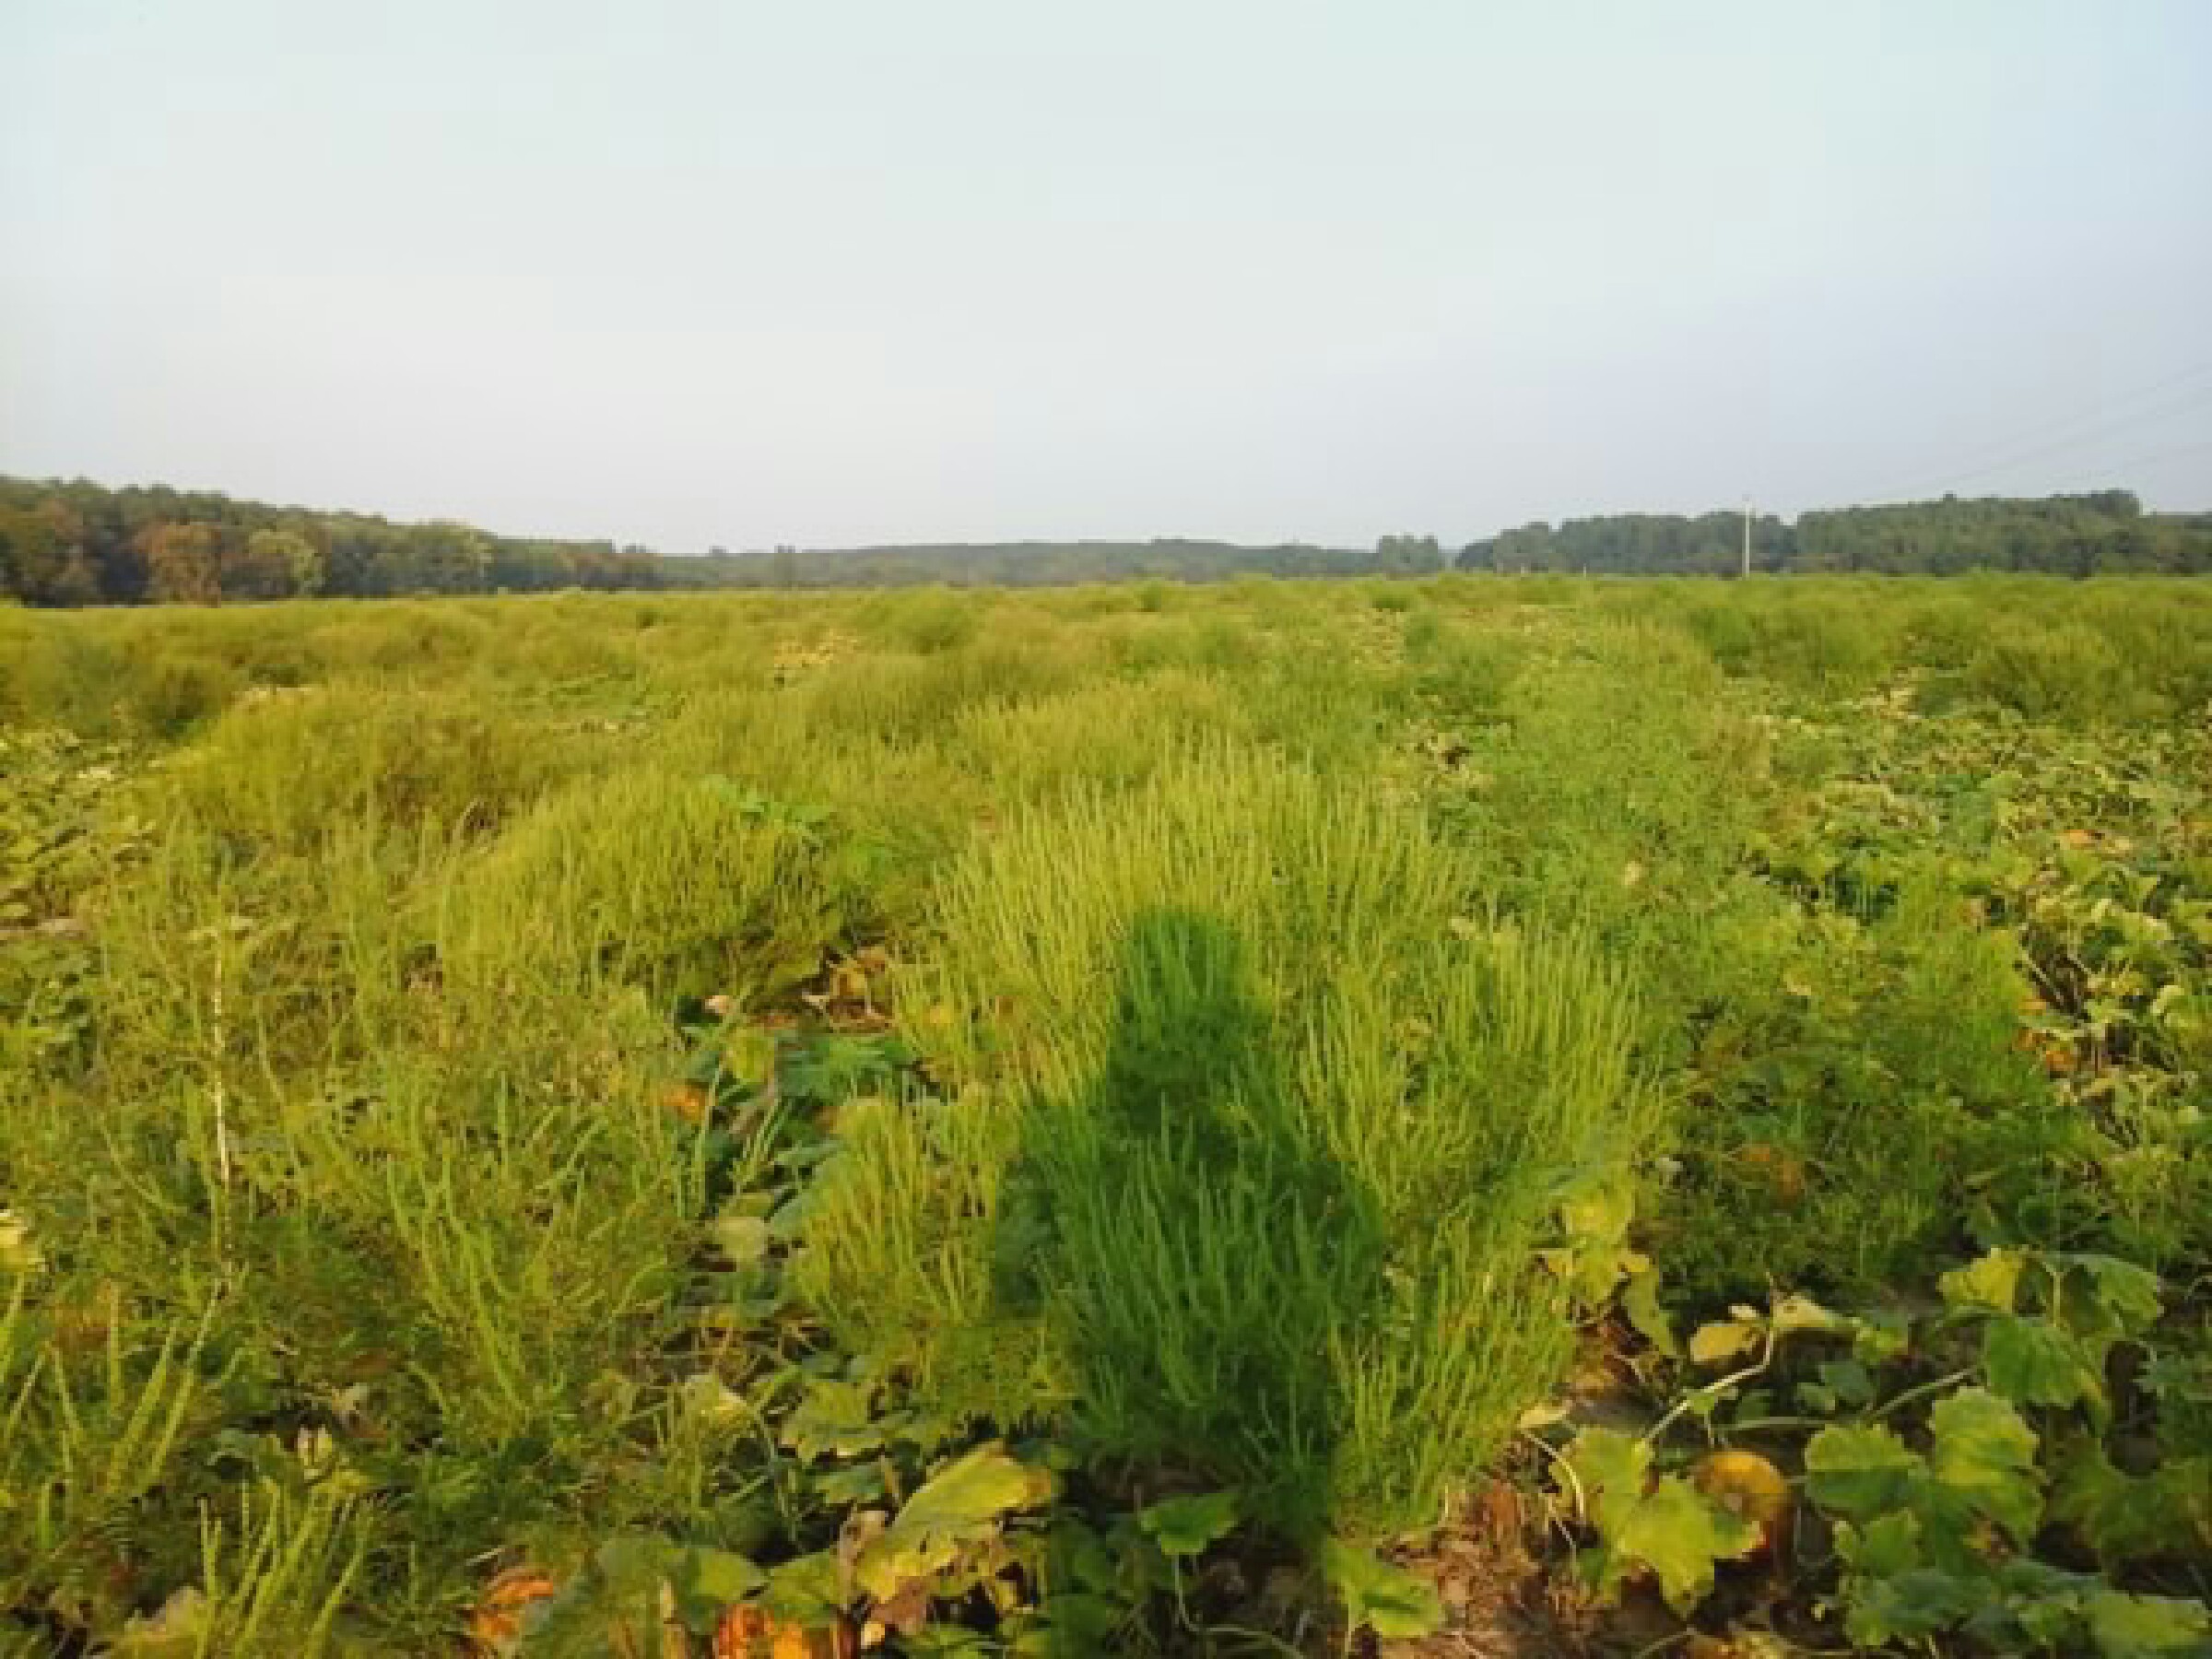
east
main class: Cropland
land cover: Other fresh vegetables
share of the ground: 25 - 50 %
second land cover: Spontaneously vegetated surfaces
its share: 25 - 50 %
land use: Agriculture (excluding fallow land and kitchen gardens)
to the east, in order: Other fresh vegetables; Spontaneously vegetated surfaces
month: August
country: HU
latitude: 48.0789
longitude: 19.3513
